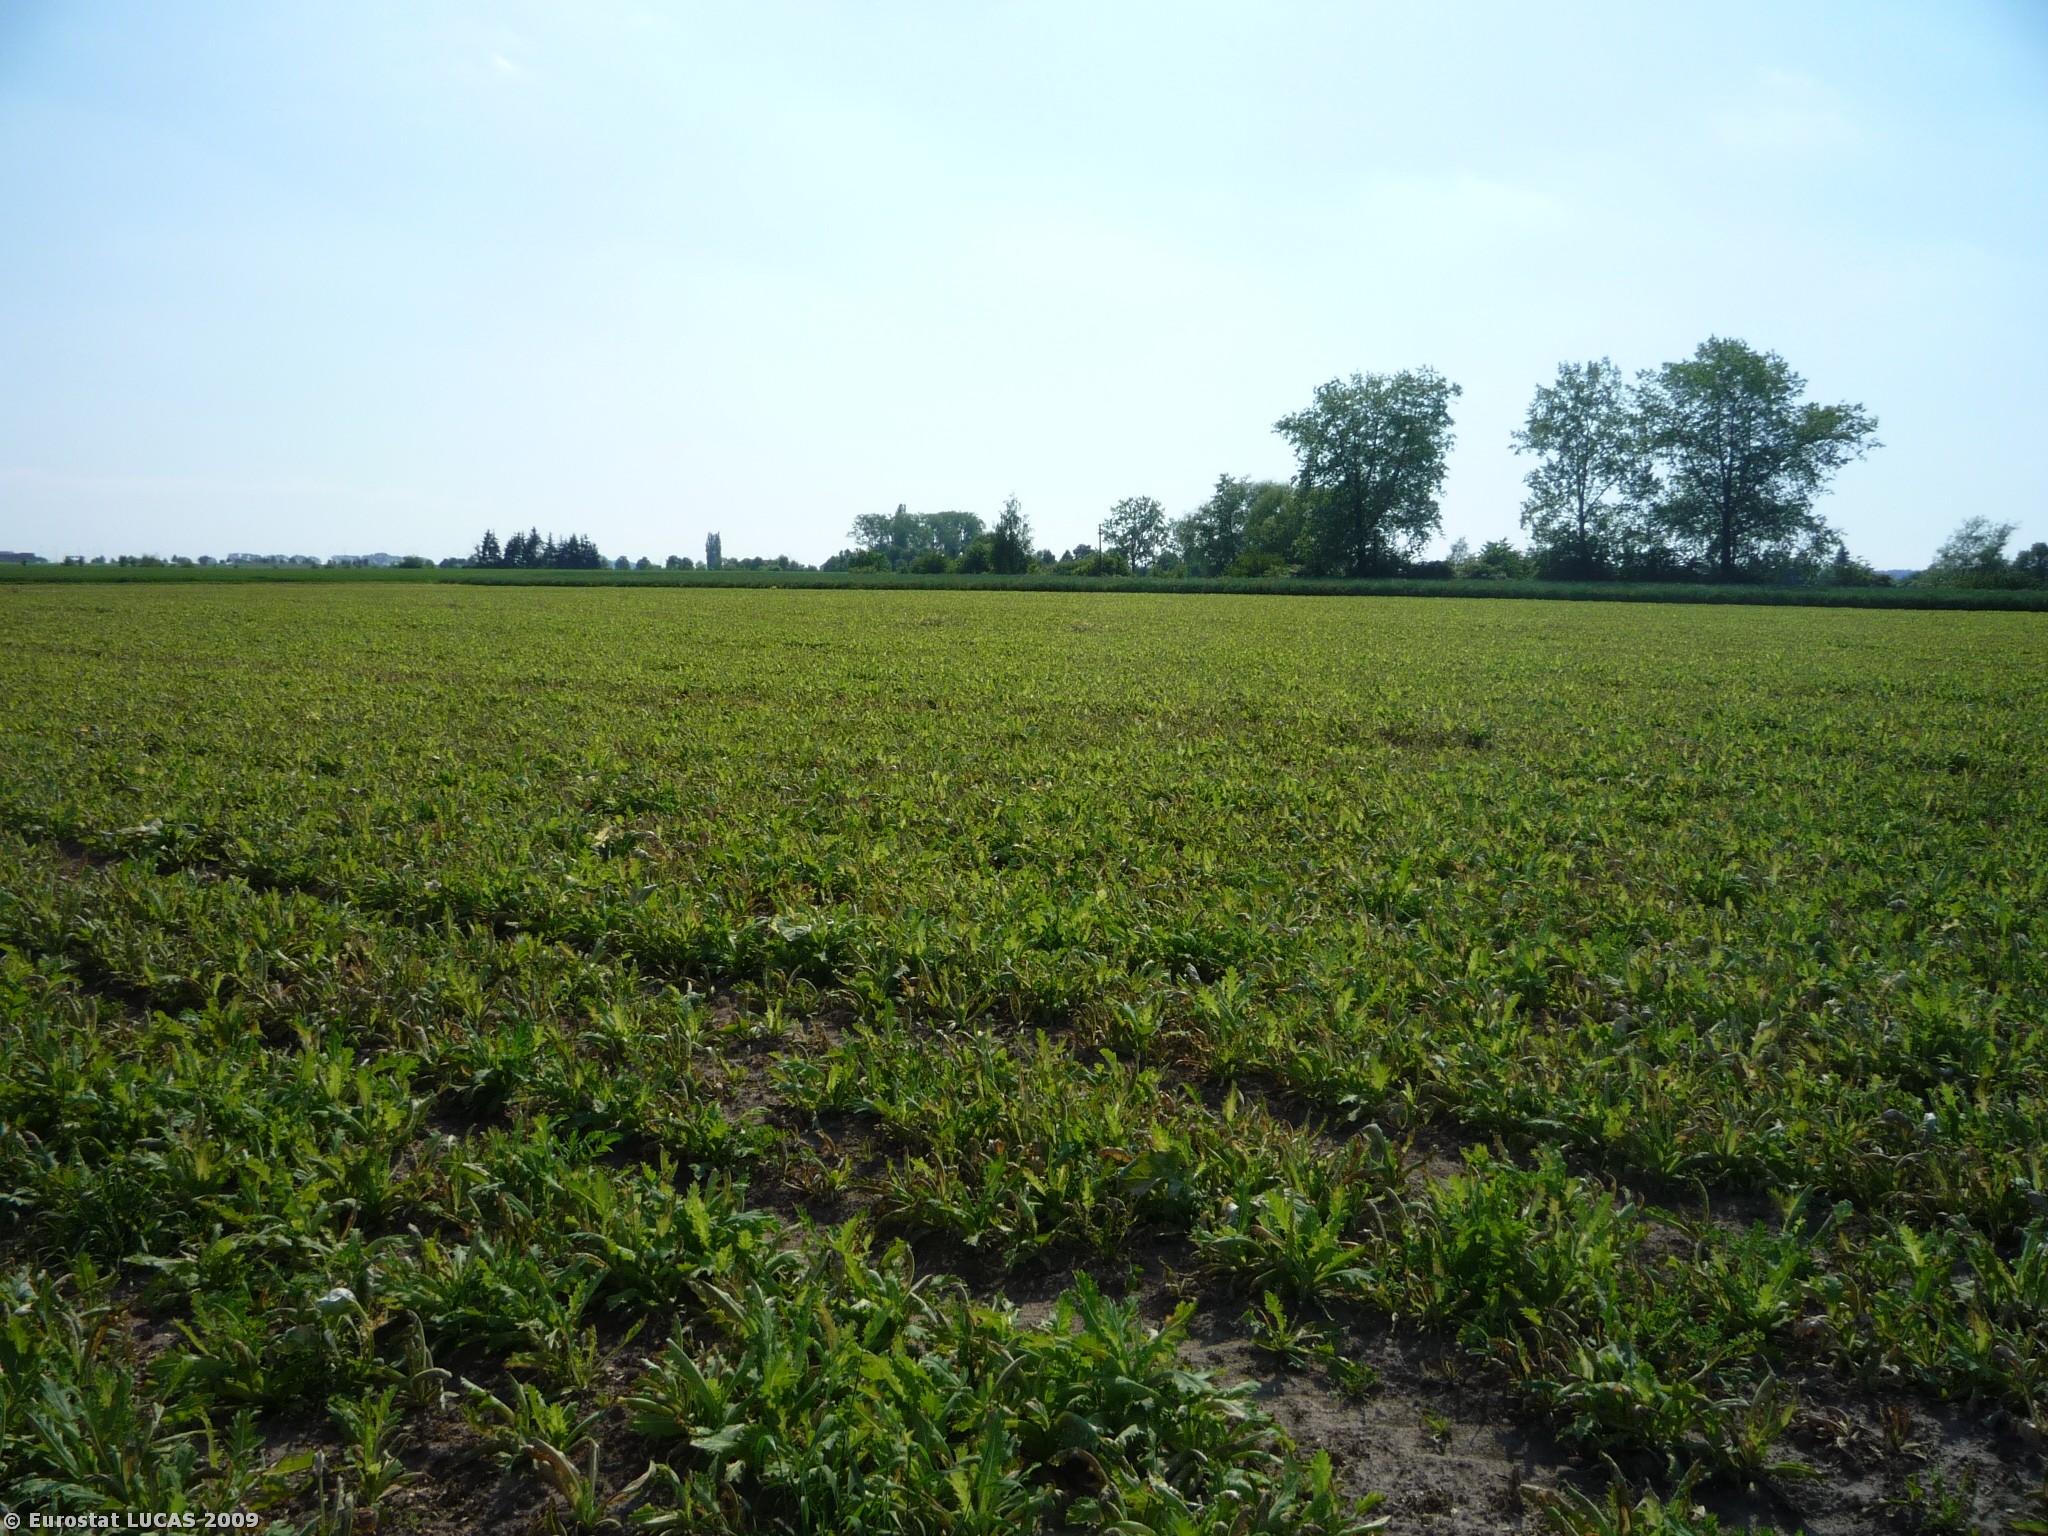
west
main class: Cropland
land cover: Other fibre and oleaginous crops
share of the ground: > 75 %
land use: Agriculture (excluding fallow land and kitchen gardens)
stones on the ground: < 10 %
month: May
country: CZ
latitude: 50.2173
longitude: 15.7930
